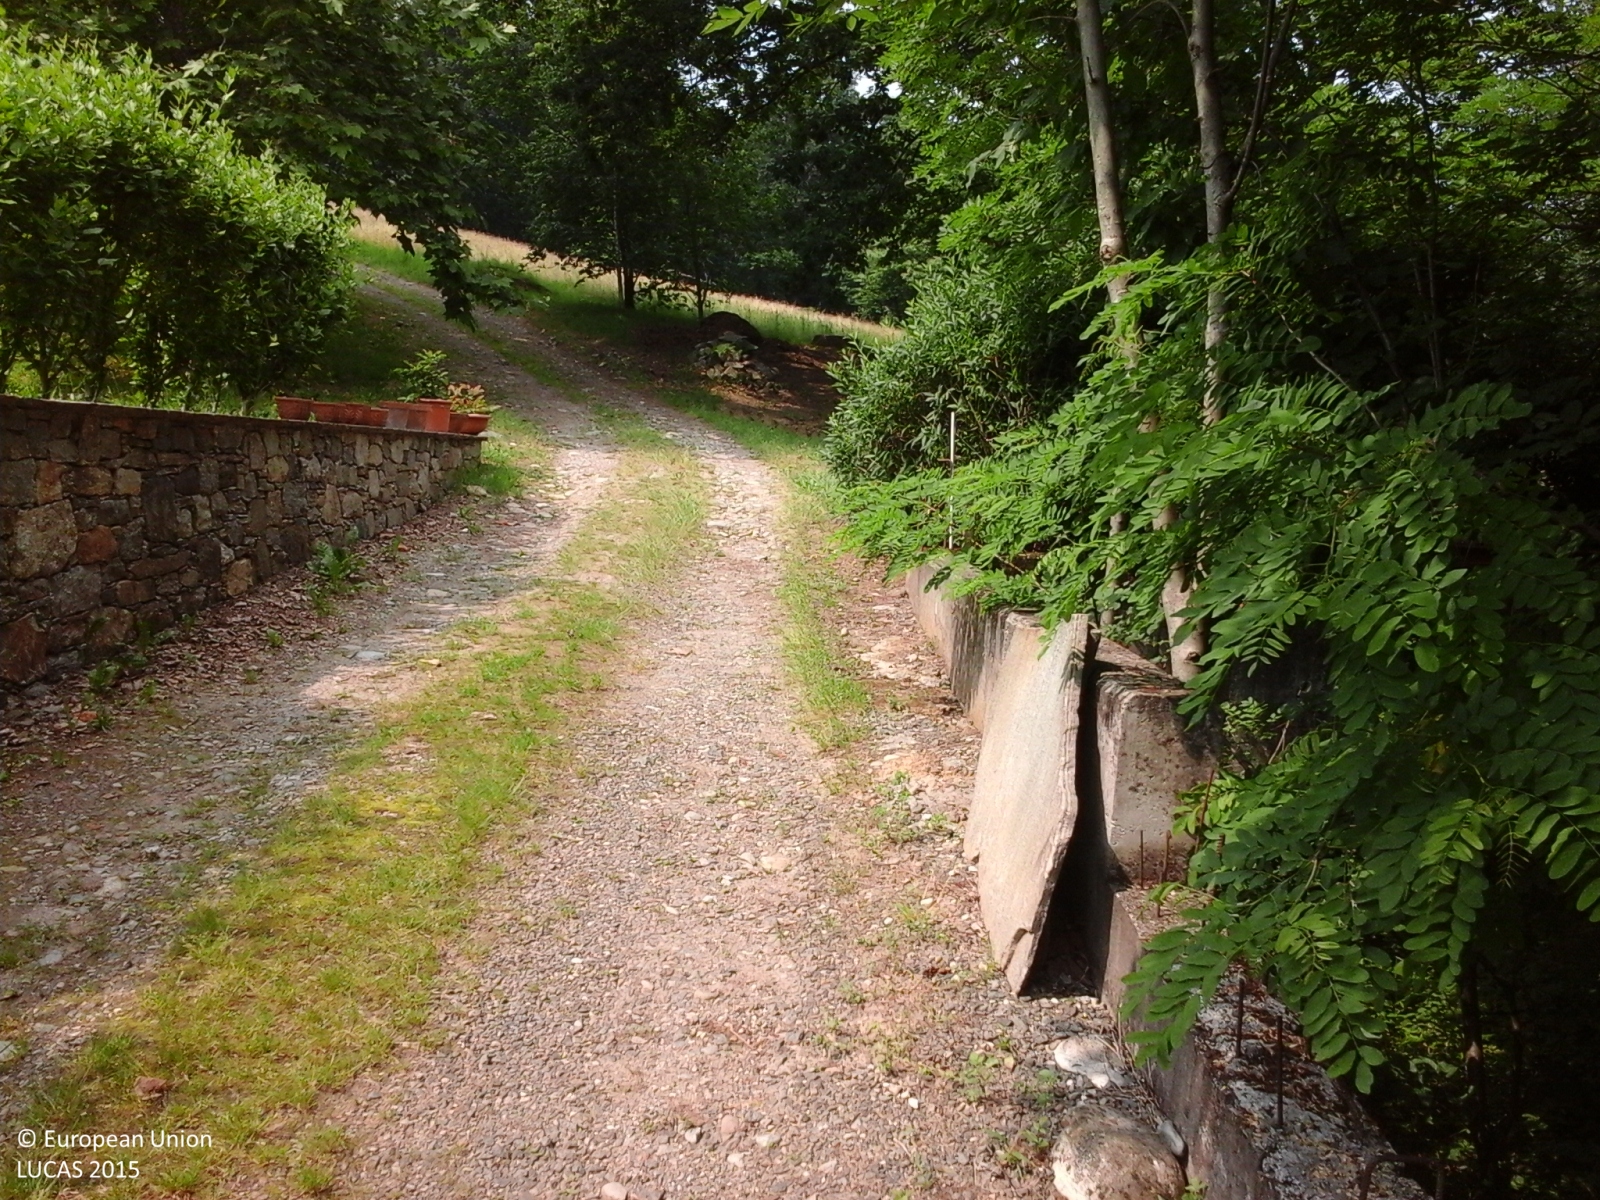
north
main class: Woodland
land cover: Broadleaved woodland
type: thermophilous deciduous forest
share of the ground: > 75 %
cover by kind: broadleaved forest trees 100 %
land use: Semi-natural and natural areas not in use
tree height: > 5 m
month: May
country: IT
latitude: 45.3896
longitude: 7.7173
